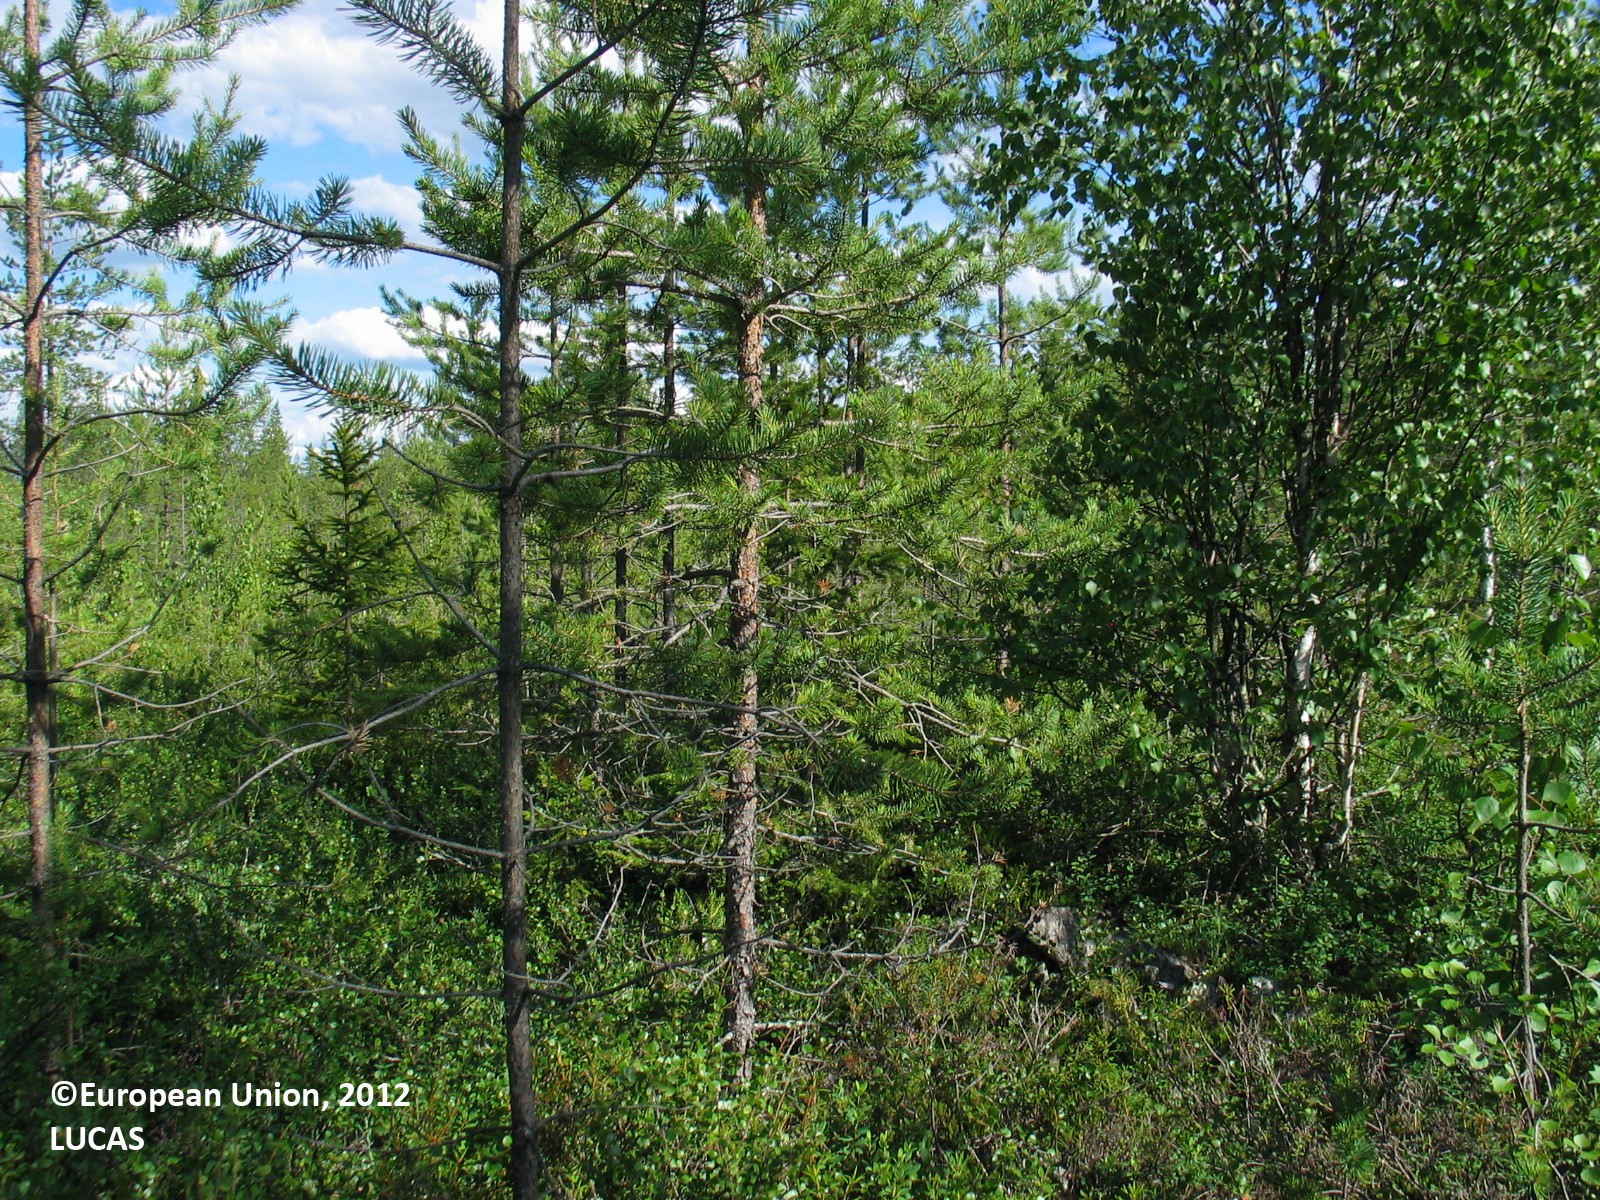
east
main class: Woodland
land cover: Pine dominated coniferous woodland
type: mire and swamp forests
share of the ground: 25 - 50 %
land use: Forestry
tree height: > 5 m
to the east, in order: Pine dominated coniferous woodland; Other mixed woodland; Ditches and canals; Pine dominated coniferous woodland; Peatbogs; Pine dominated coniferous woodland
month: July
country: FI
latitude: 65.9213
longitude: 24.9310
